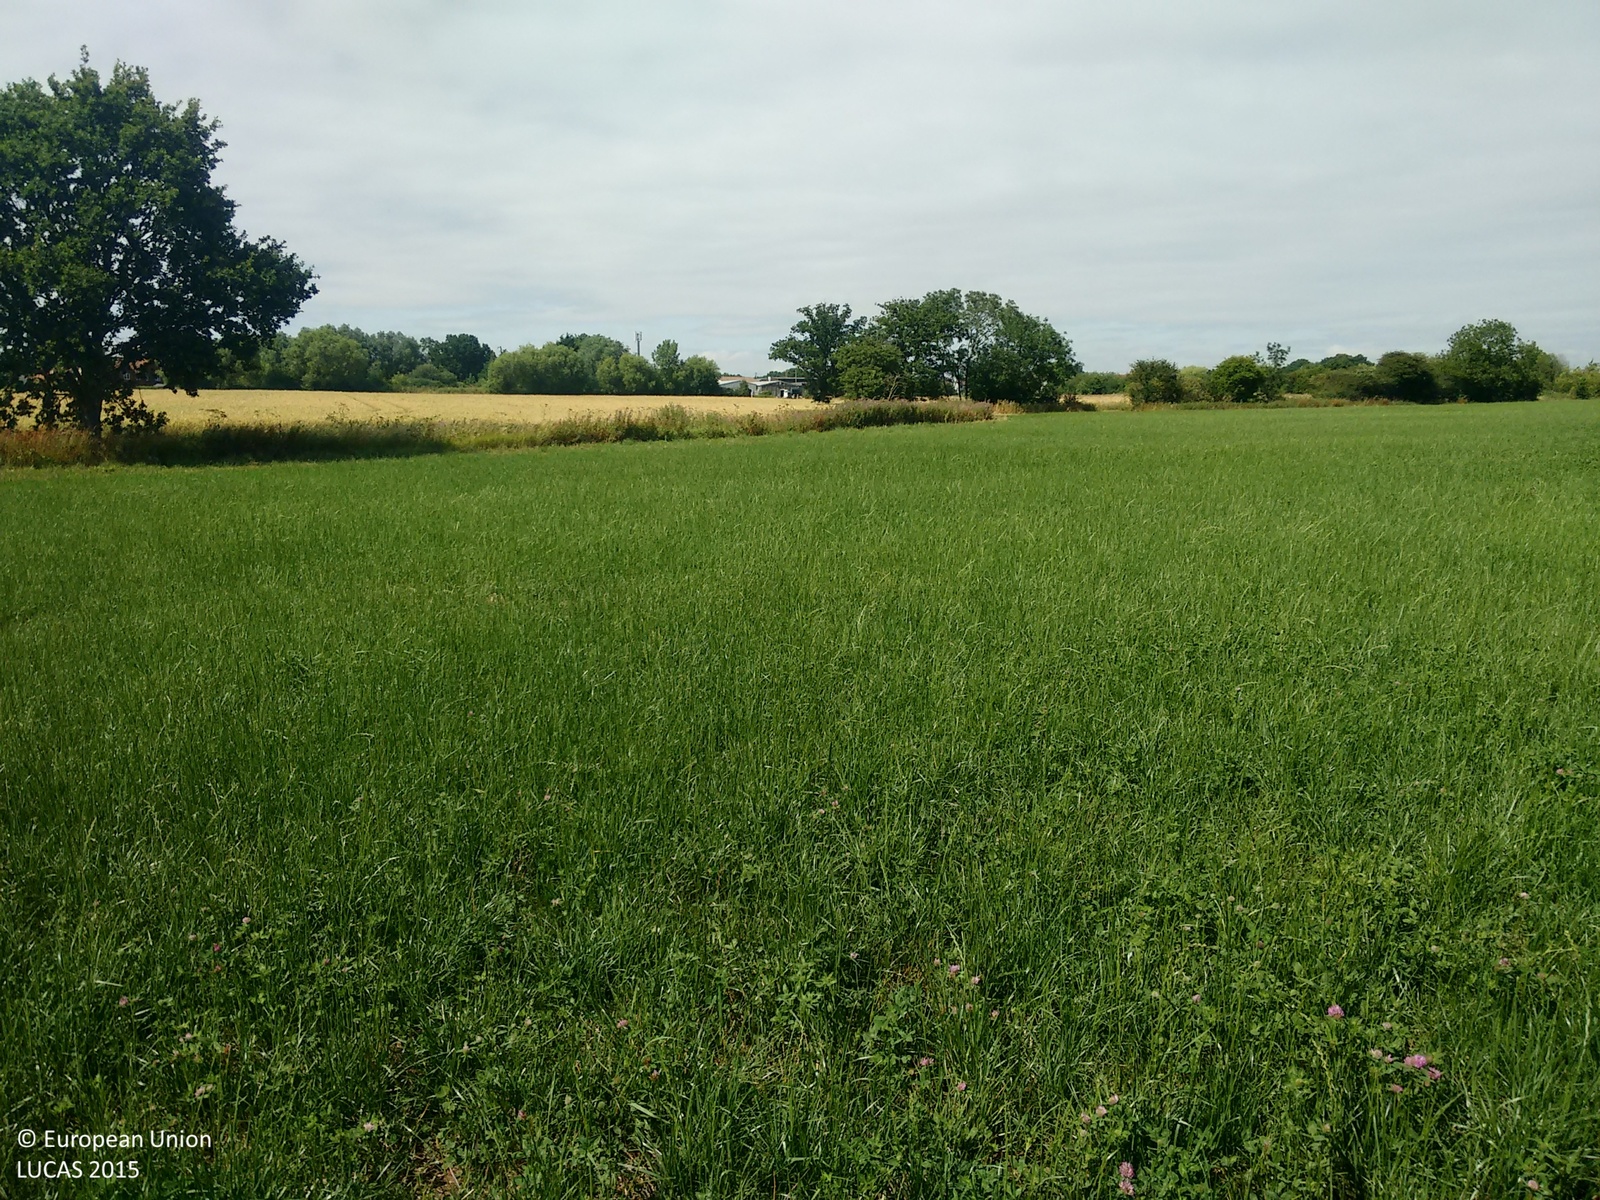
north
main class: Cropland
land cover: Temporary grasslands
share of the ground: > 75 %
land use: Agriculture (excluding fallow land and kitchen gardens)
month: July
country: GB
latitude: 51.6746
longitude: 0.5586
